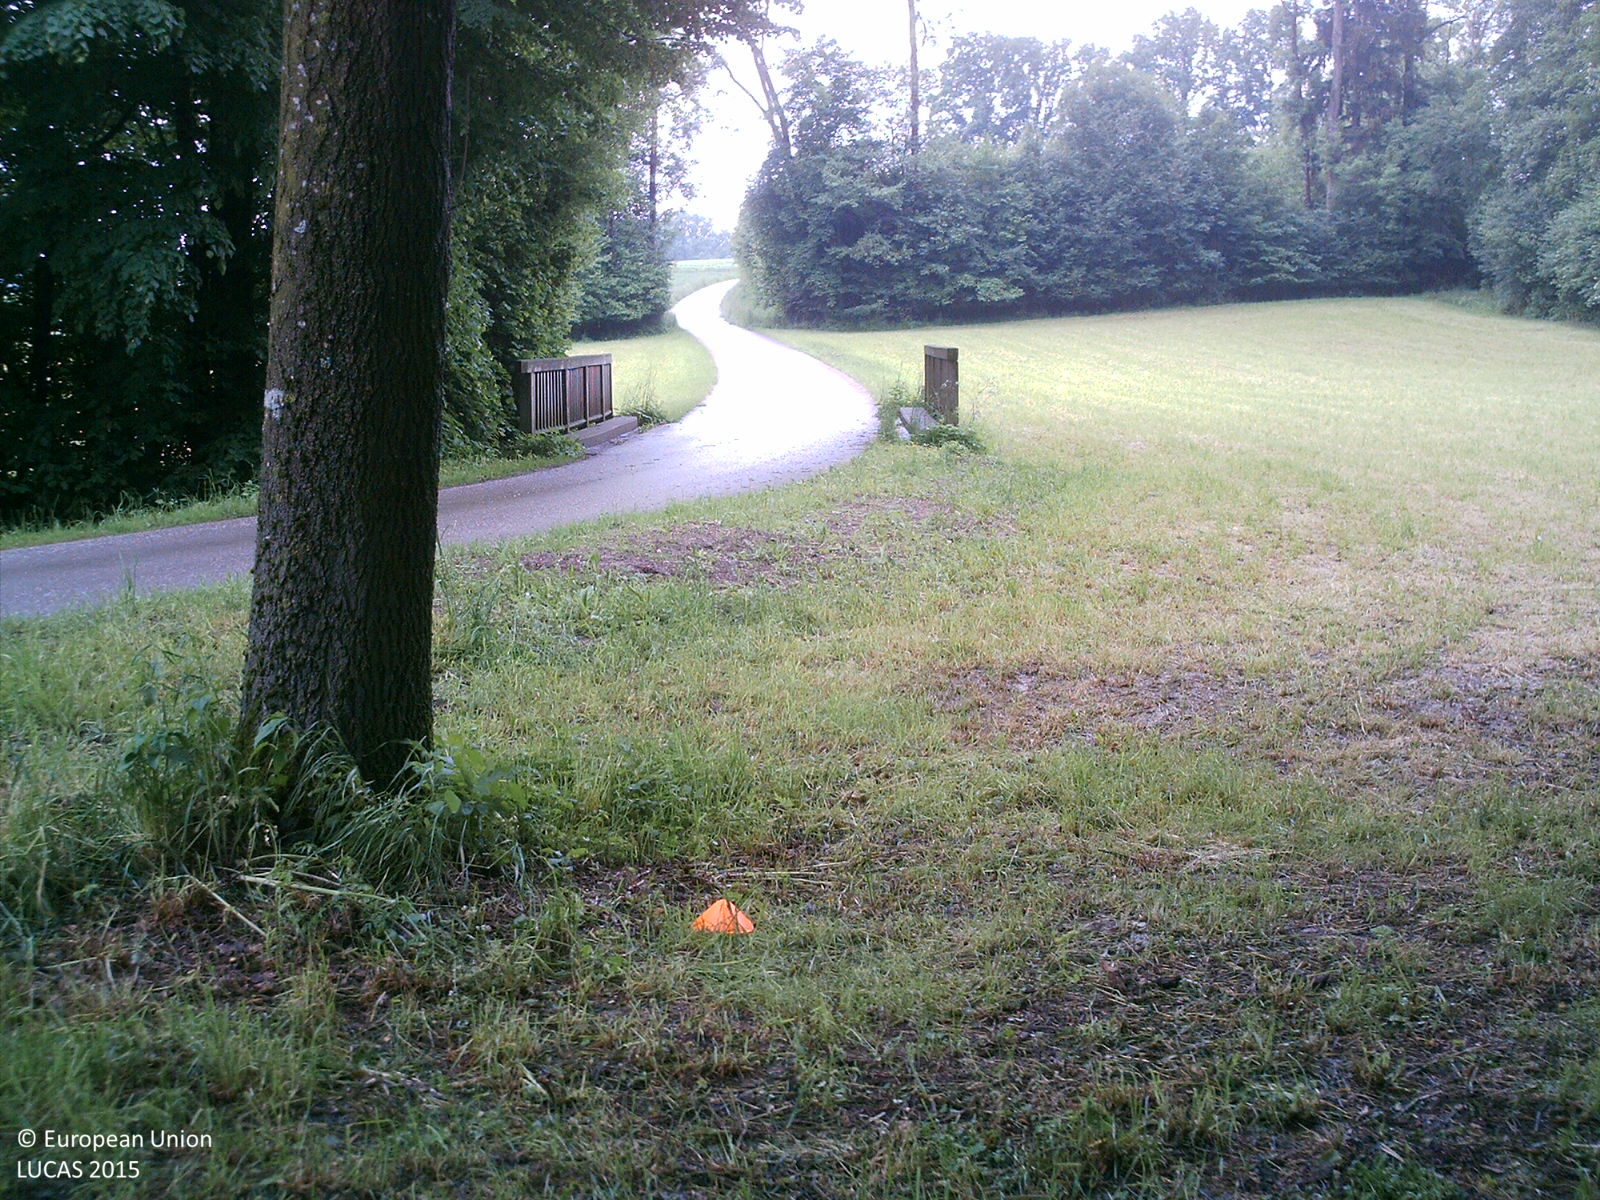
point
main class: Woodland
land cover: Spruce dominated mixed woodland
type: mesophytic deciduous forest
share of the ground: > 75 %
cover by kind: coniferous forest trees 60 %, broadleaved forest trees 40 %
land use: Forestry
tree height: > 5 m
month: May
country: AT
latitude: 48.0904
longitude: 14.1752
